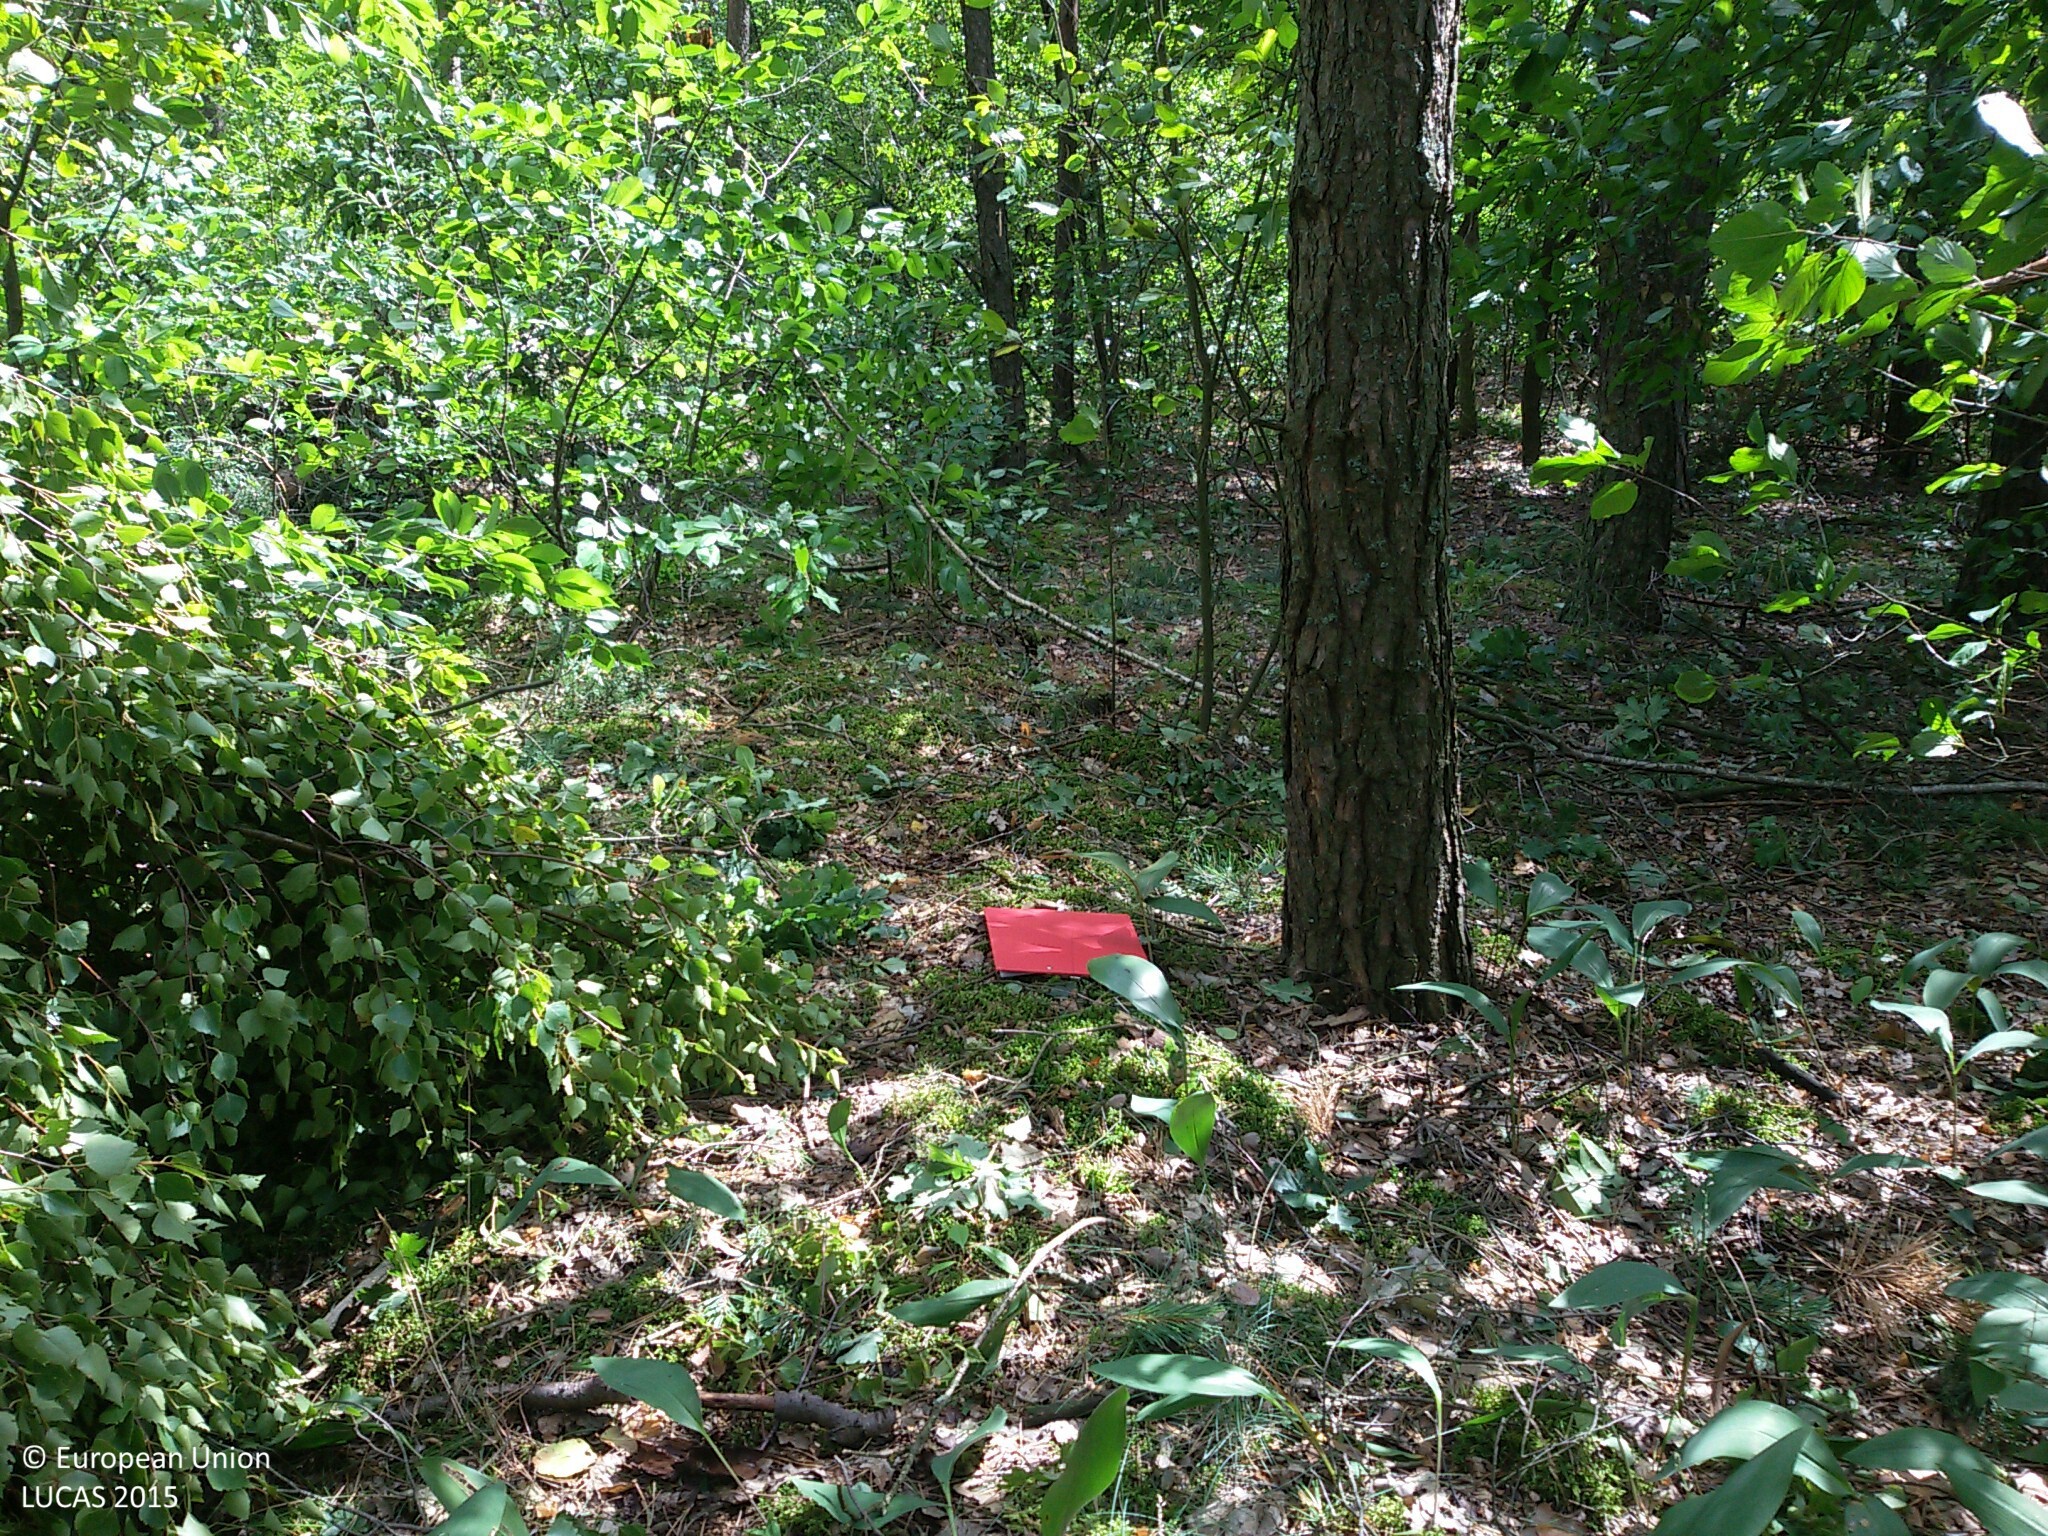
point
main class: Woodland
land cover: Pine dominated mixed woodland
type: hemiboreal forest and nemoral coniferous forest and mixed broadleaved-coniferous forest
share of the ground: 50 - 75 %
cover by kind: coniferous forest trees 45 %, broadleaved forest trees 25 %, shrubs 10 %, herbaceous plants 10 %, lichens and mosses 5 %, unconsolidated bare surface 5 %
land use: Forestry
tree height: > 5 m
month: July
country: PL
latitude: 52.9929
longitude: 21.3563
